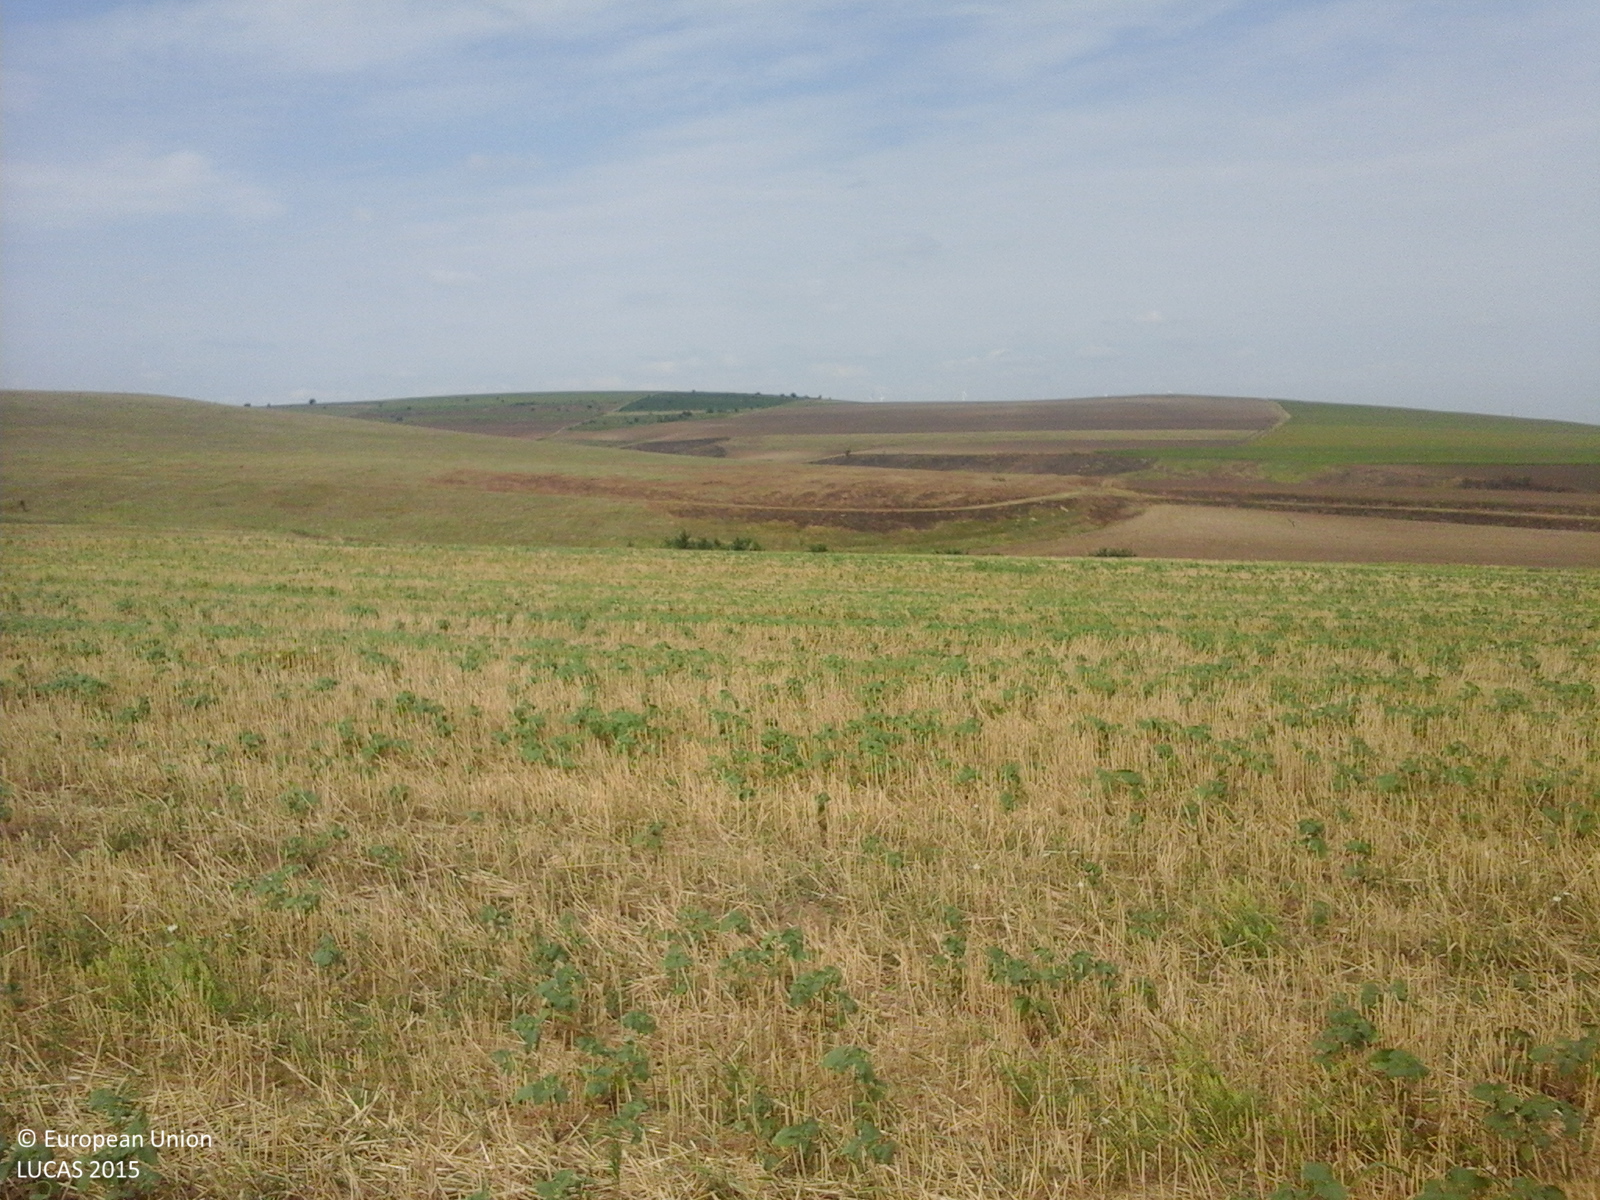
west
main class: Cropland
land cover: Common wheat
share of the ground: < 10 %
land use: Agriculture (excluding fallow land and kitchen gardens)
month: August
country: RO
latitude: 44.8929
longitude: 28.7628
